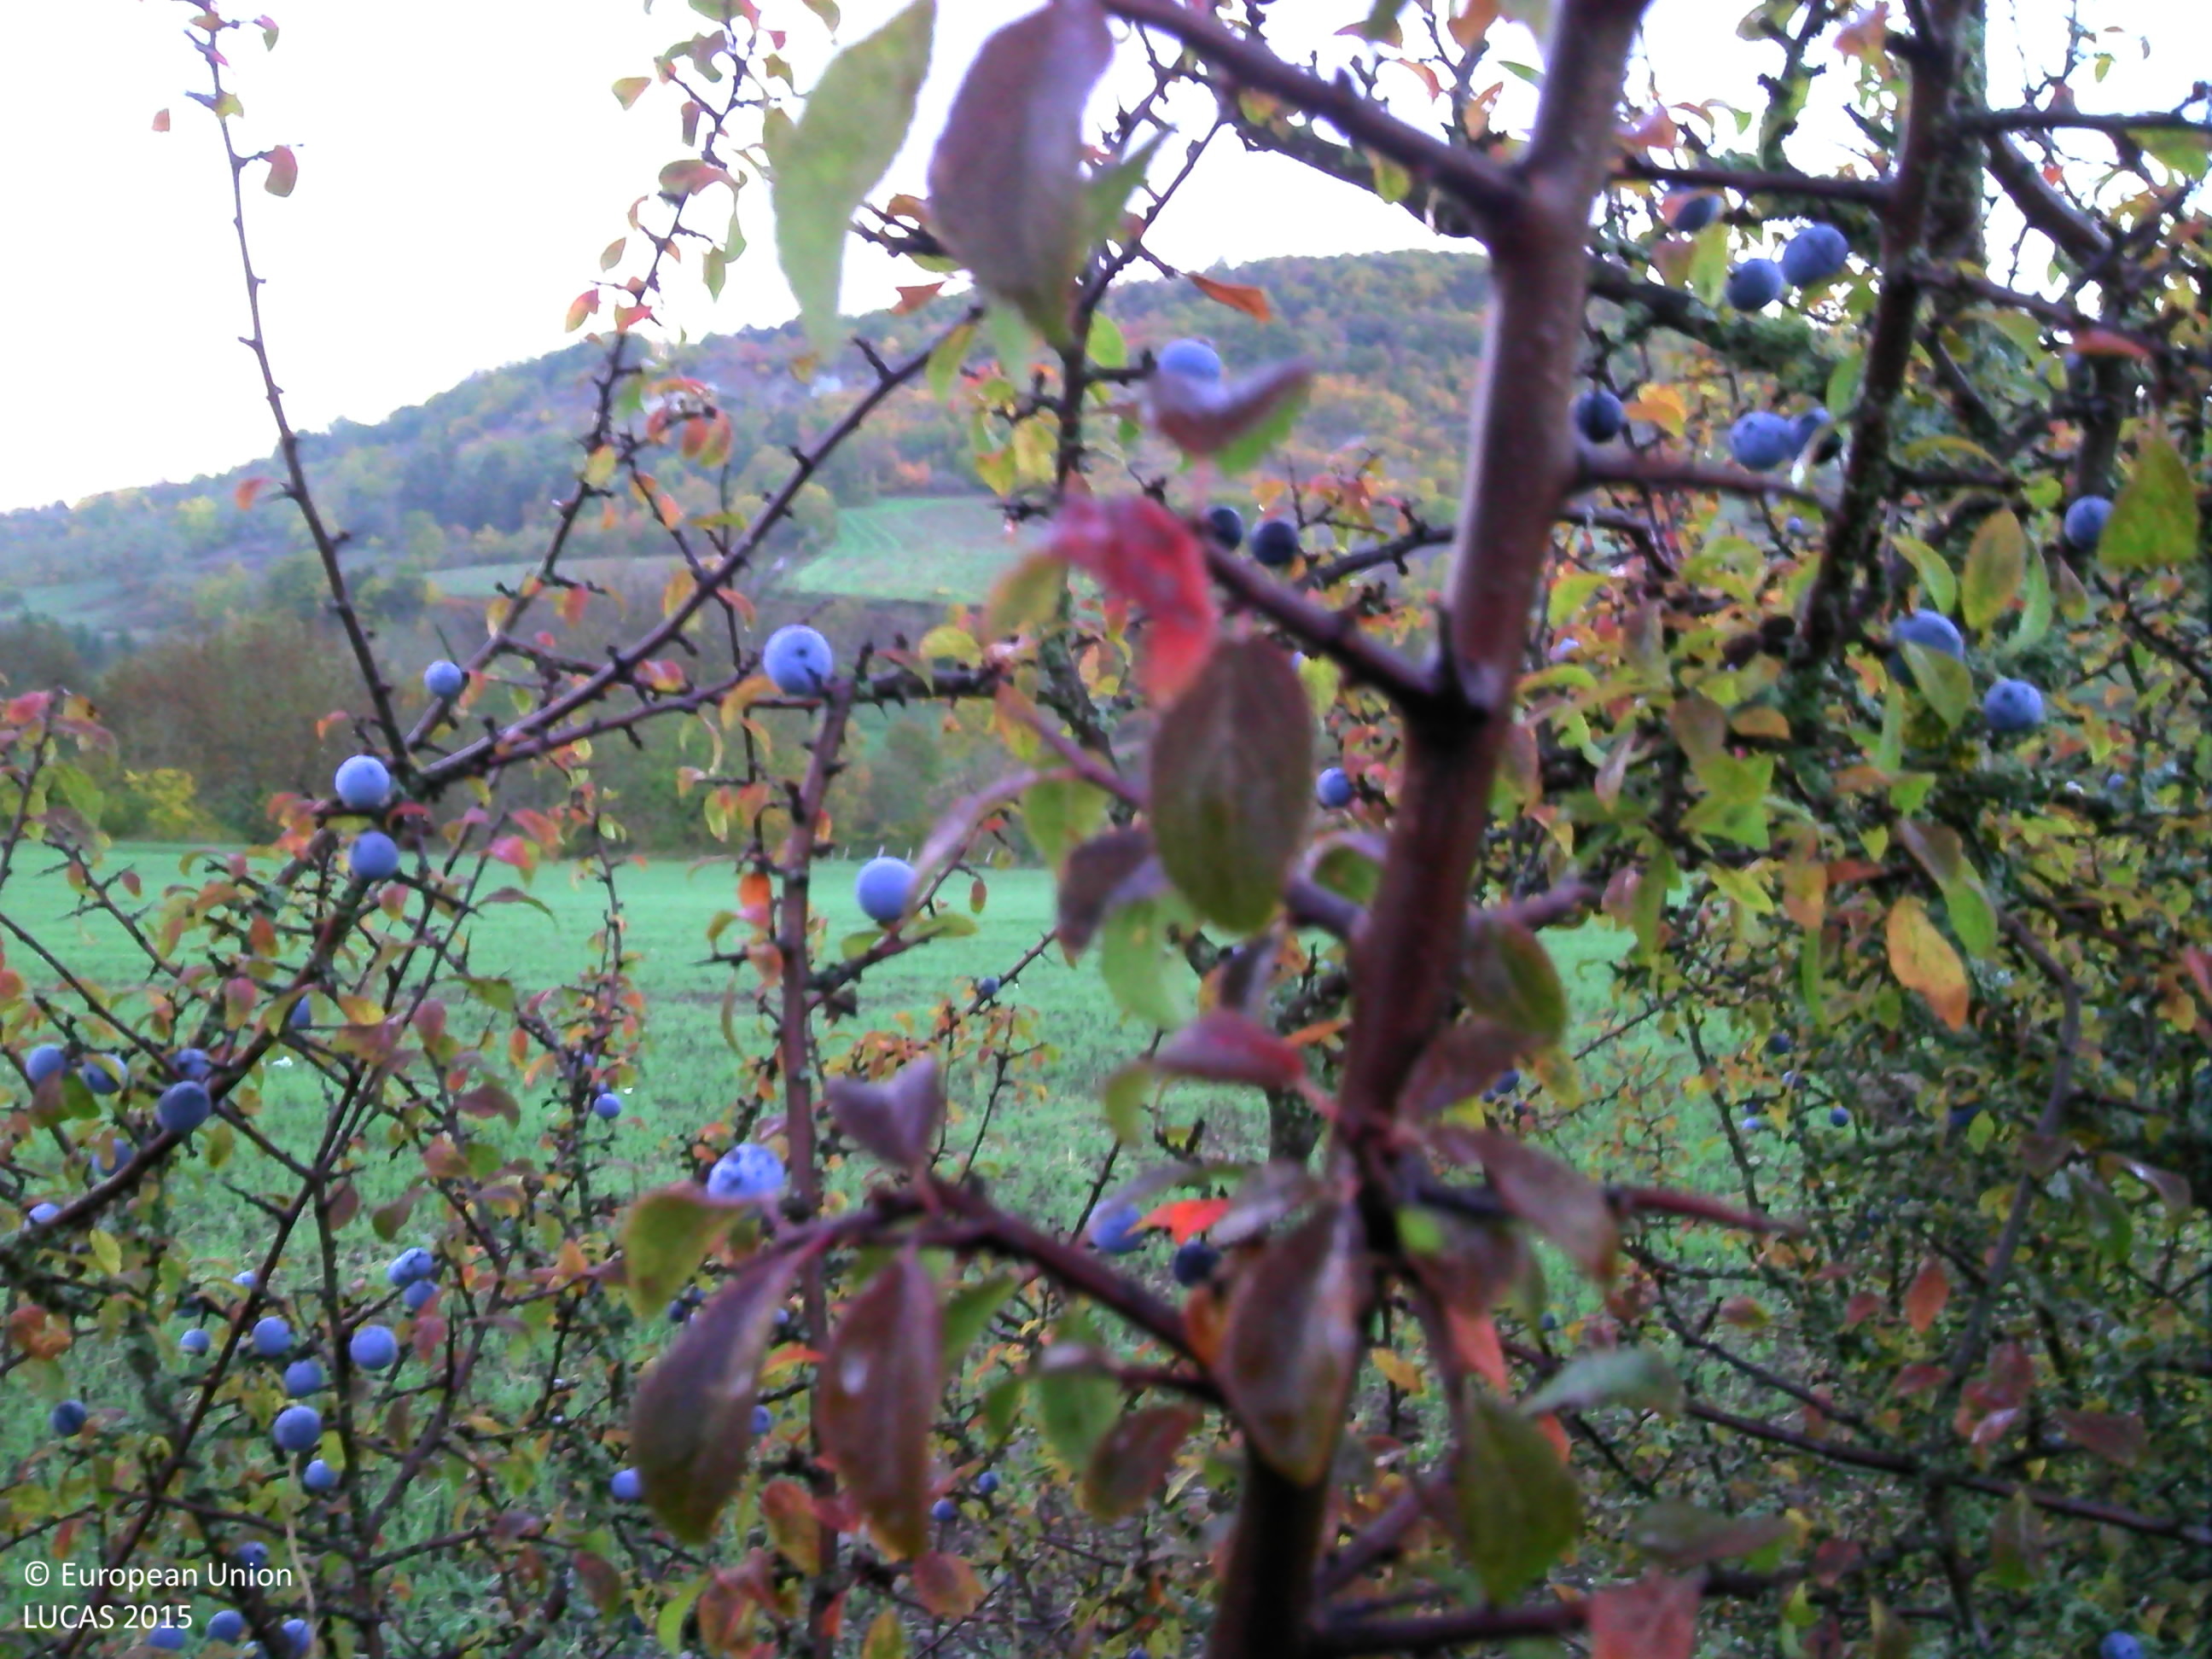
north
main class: Cropland
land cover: Common wheat
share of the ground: 25 - 50 %
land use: Agriculture (excluding fallow land and kitchen gardens)
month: October
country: FR
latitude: 45.0911
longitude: 3.8669
